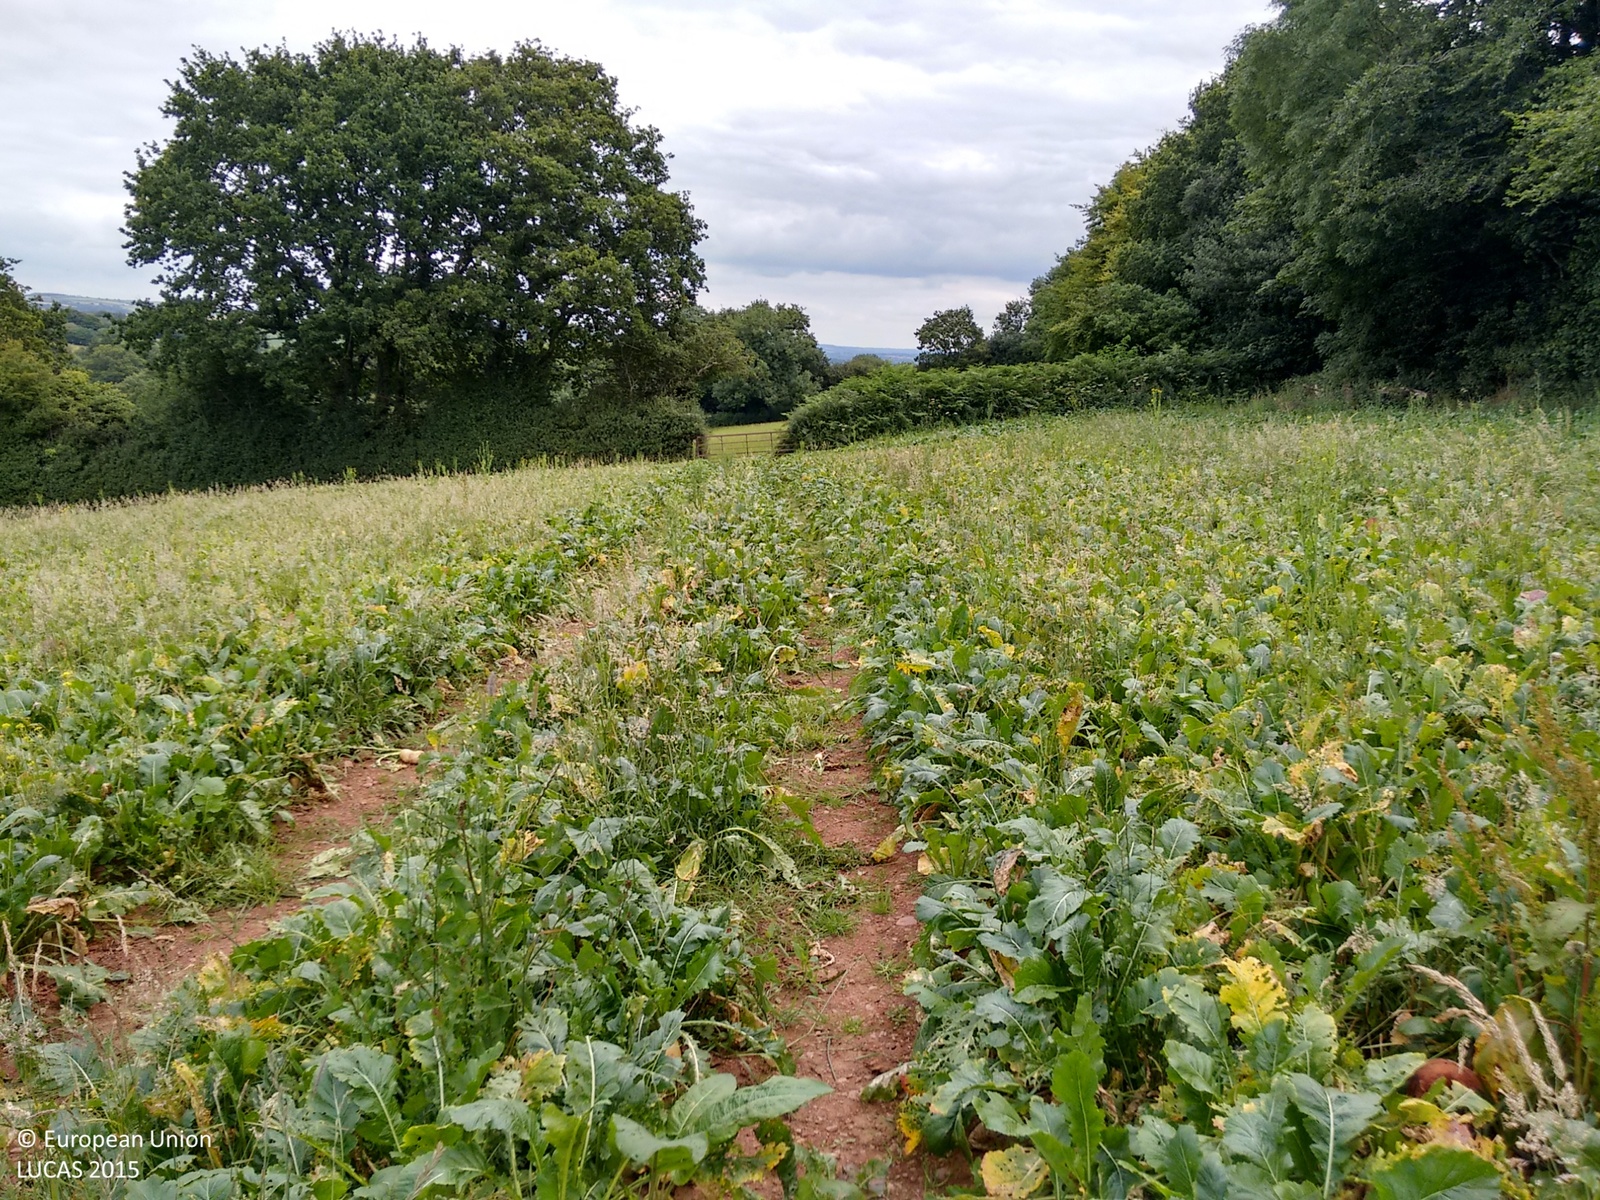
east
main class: Cropland
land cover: Other leguminous and mixtures for fodder
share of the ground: > 75 %
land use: Agriculture (excluding fallow land and kitchen gardens)
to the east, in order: Other leguminous and mixtures for fodder; Managed hedges; Grassland without tree/shrub cover; Managed hedges; Grass margins; Tracks; Grass margins; Managed hedges; Grassland without tree/shrub cover
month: August
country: GB
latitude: 50.9201
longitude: -3.5565
